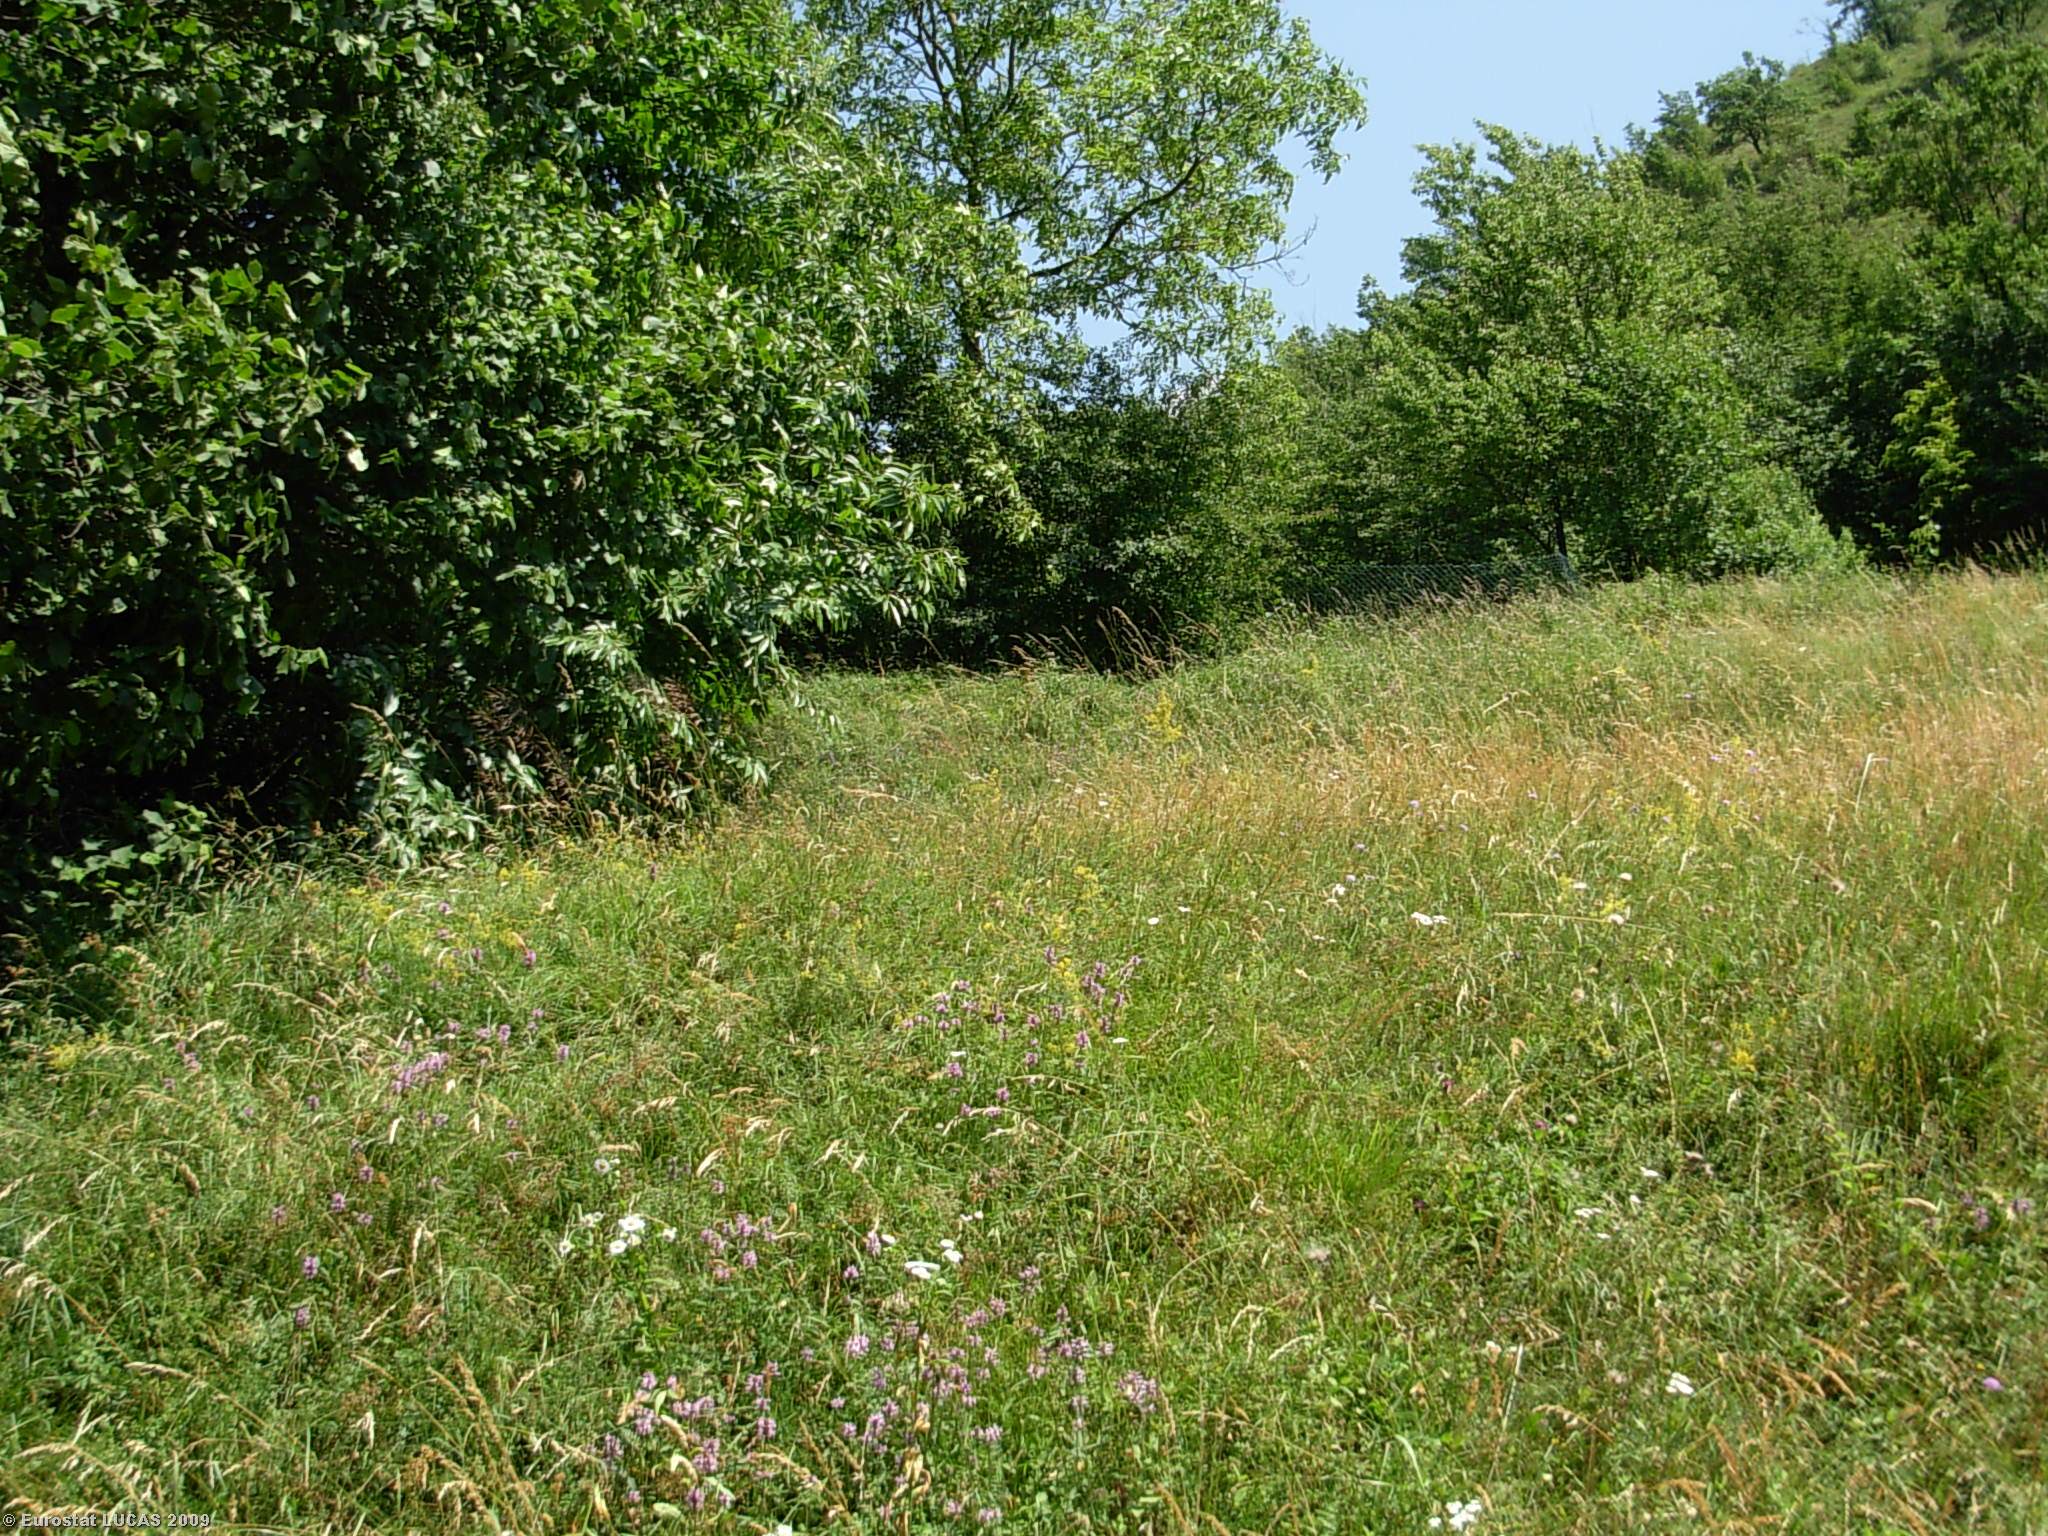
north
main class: Woodland
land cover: Broadleaved woodland
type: mesophytic deciduous forest
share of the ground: > 75 %
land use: Forestry
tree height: > 5 m
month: June
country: IT
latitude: 45.6654
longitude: 10.4998
